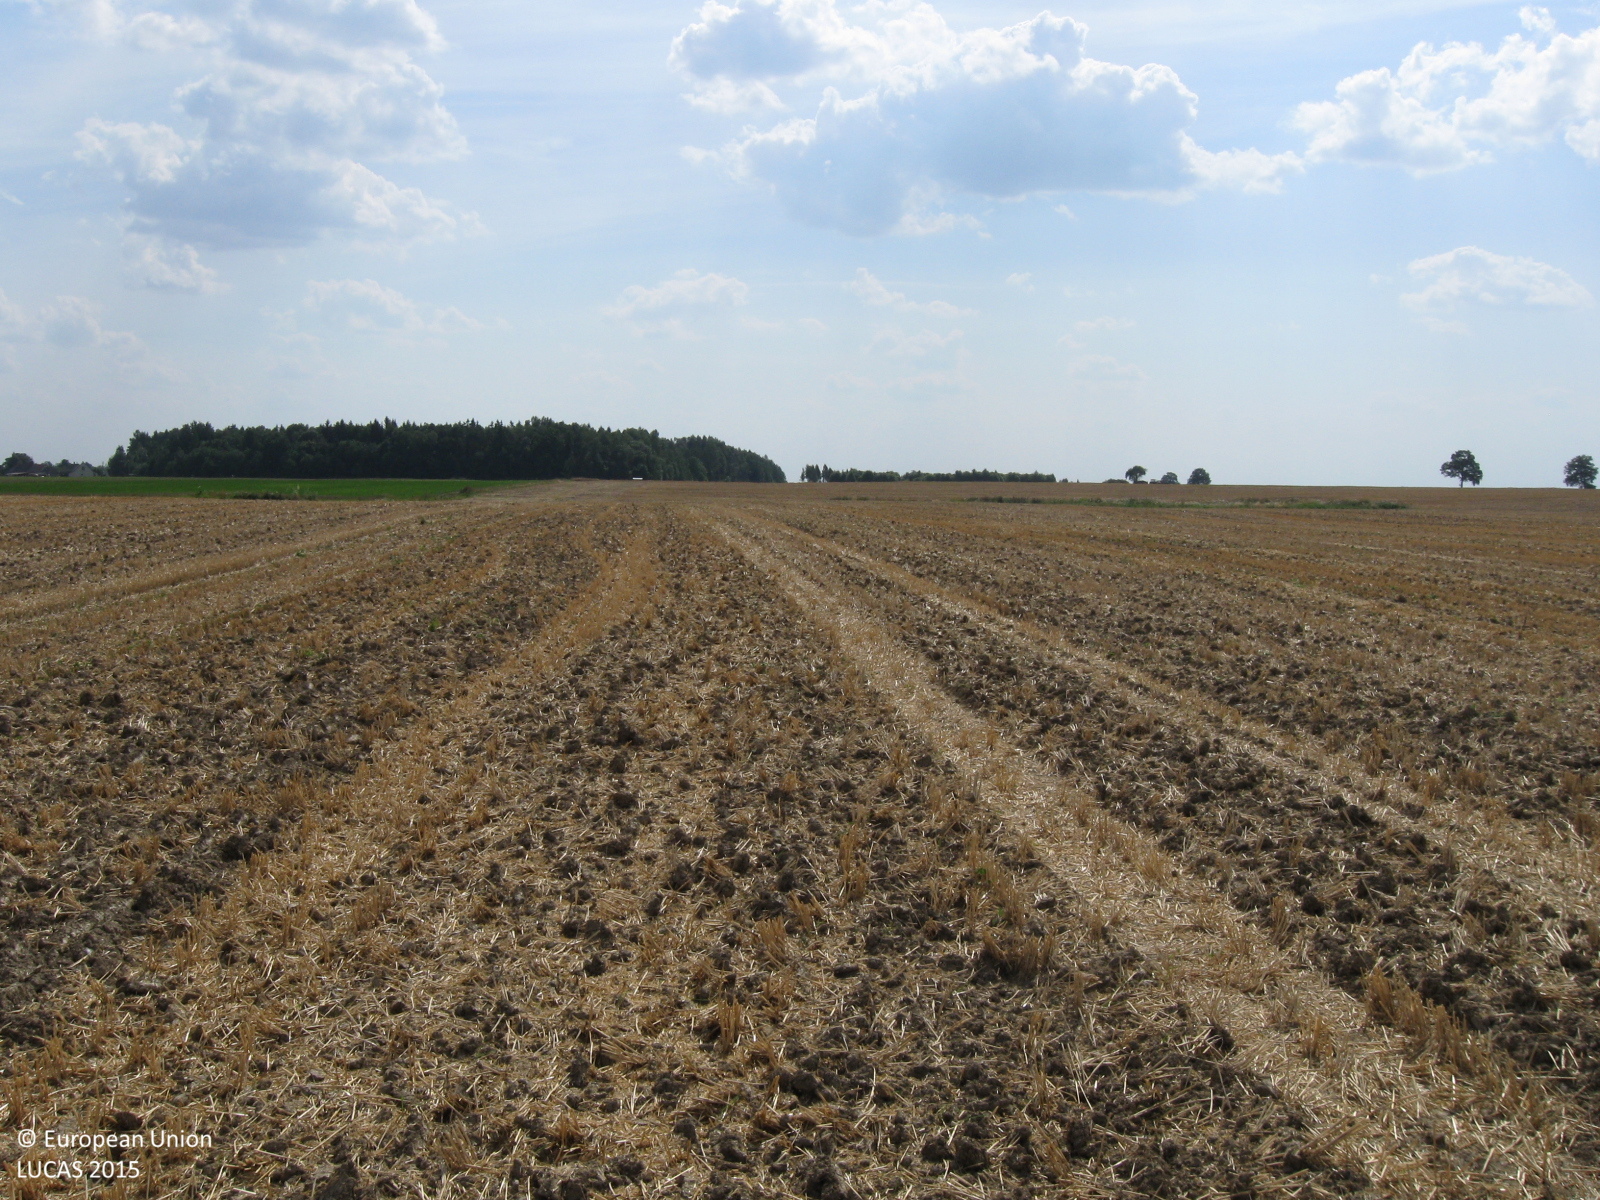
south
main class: Cropland
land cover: Common wheat
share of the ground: < 10 %
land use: Agriculture (excluding fallow land and kitchen gardens)
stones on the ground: < 10 %
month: August
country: LT
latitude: 55.5169
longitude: 22.8800
